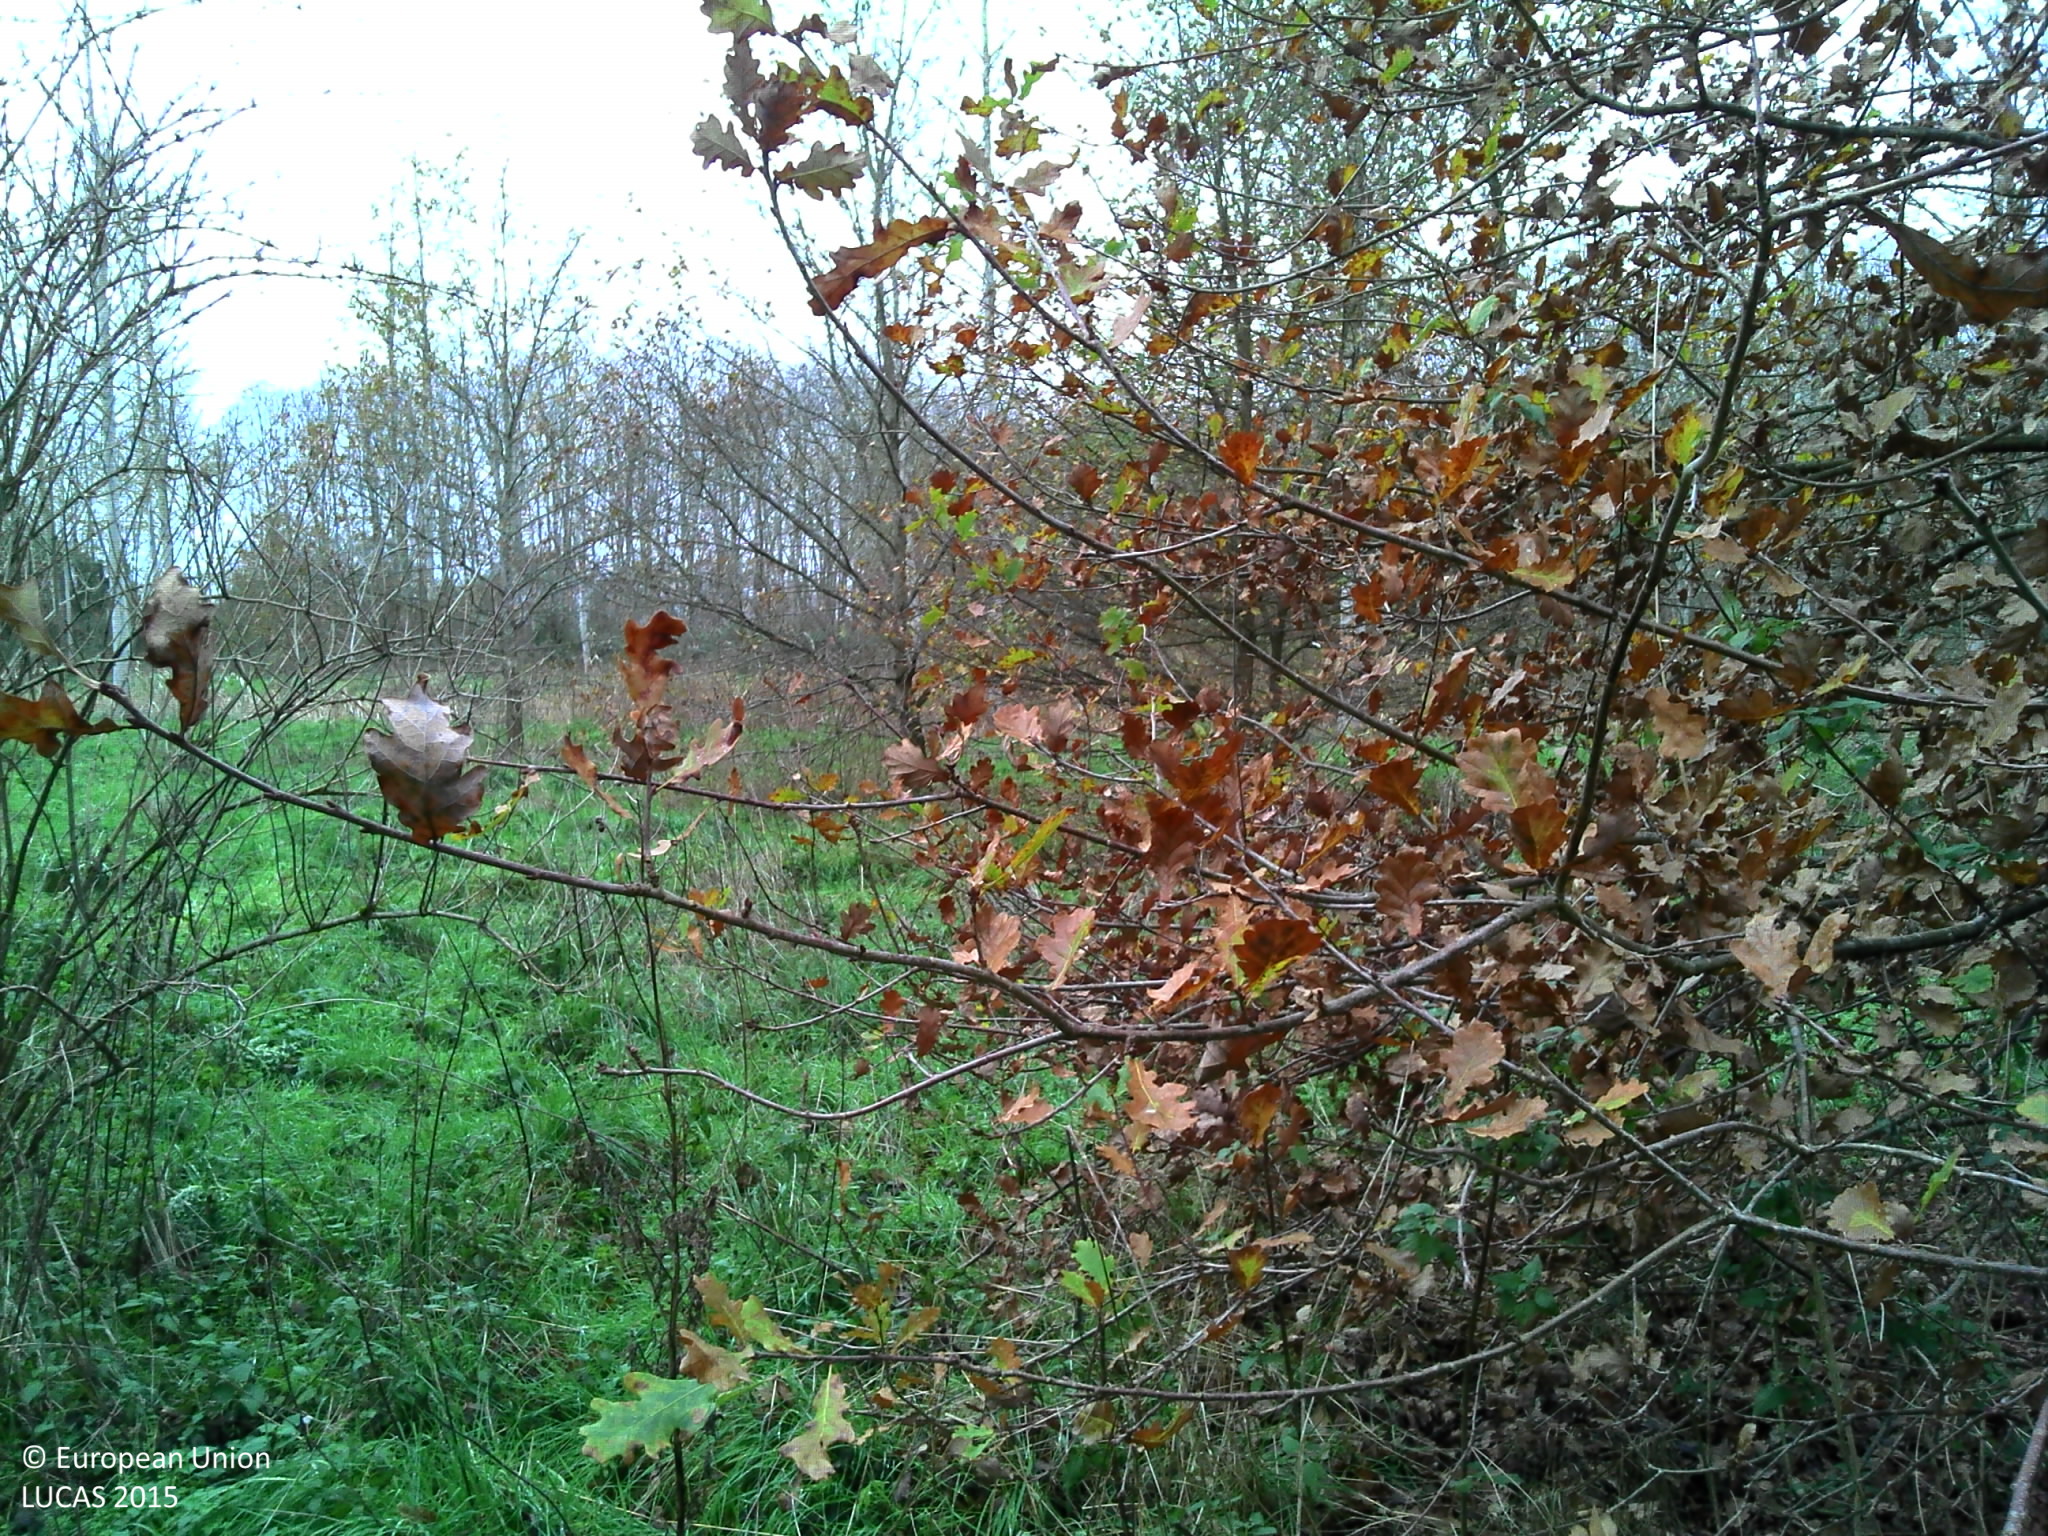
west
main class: Woodland
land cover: Broadleaved woodland
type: acidophilous oak and oak-birch forest
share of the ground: > 75 %
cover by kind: broadleaved forest trees 60 %, herbaceous plants 30 %, shrubs 10 %
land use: Forestry
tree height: > 5 m
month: November
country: FR
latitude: 46.6825
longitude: 3.2907
